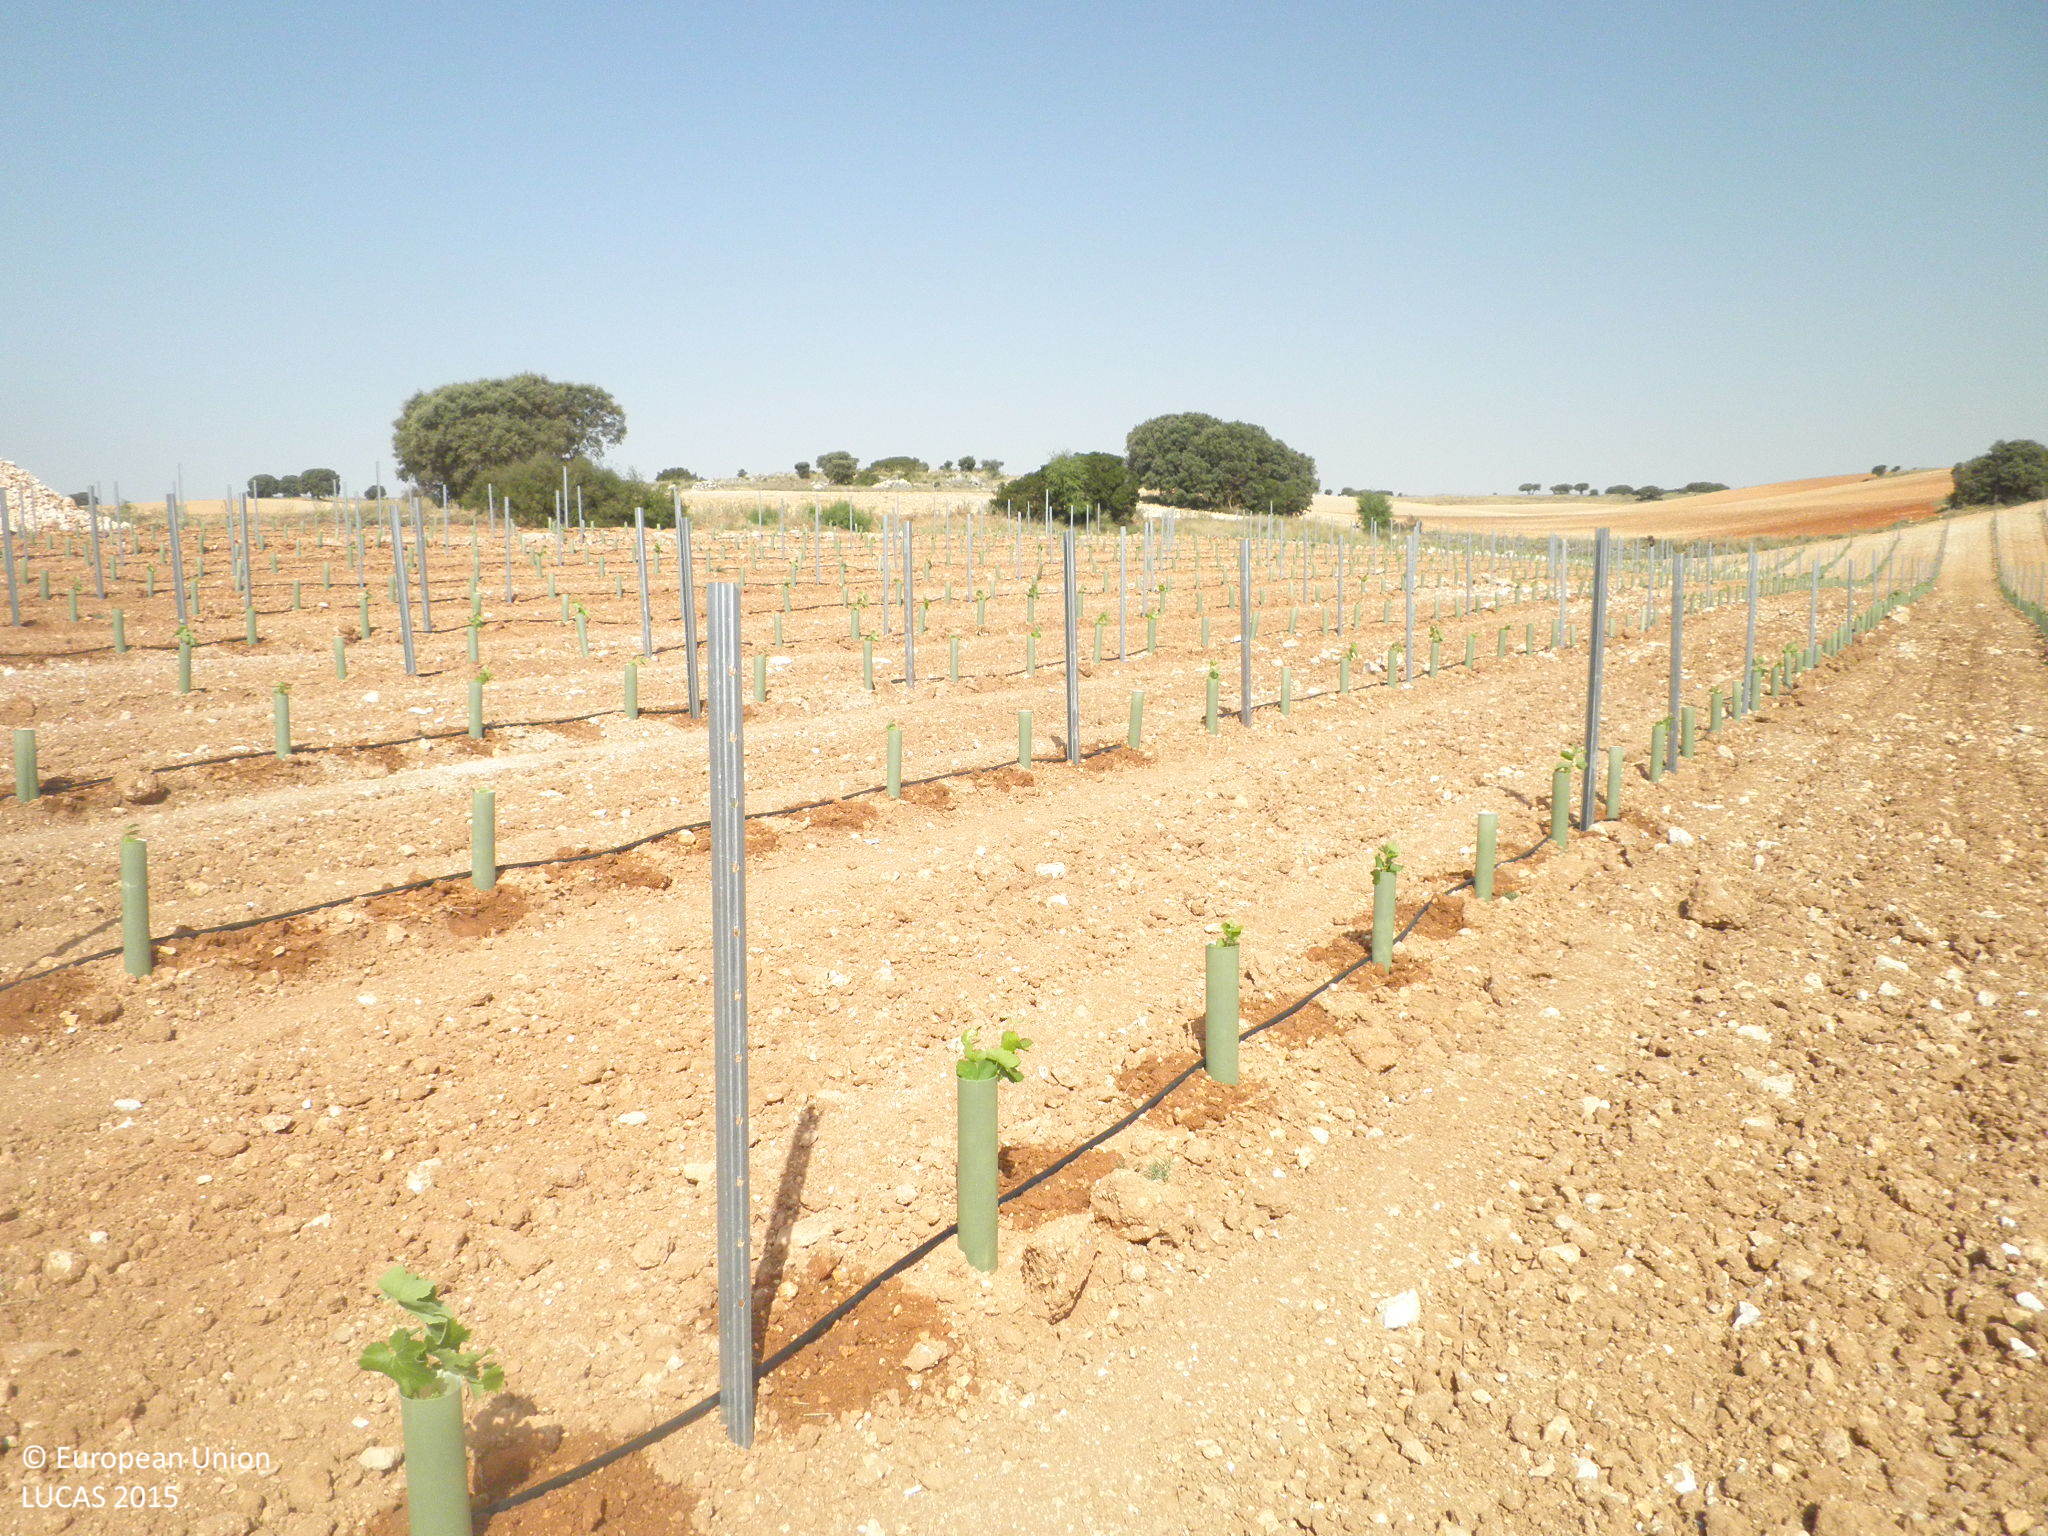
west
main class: Cropland
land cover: Vineyards
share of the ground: < 10 %
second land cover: Other bare soil
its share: > 75 %
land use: Agriculture (excluding fallow land and kitchen gardens)
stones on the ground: 10 - 25 %
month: July
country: ES
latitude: 39.6301
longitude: -2.6327
